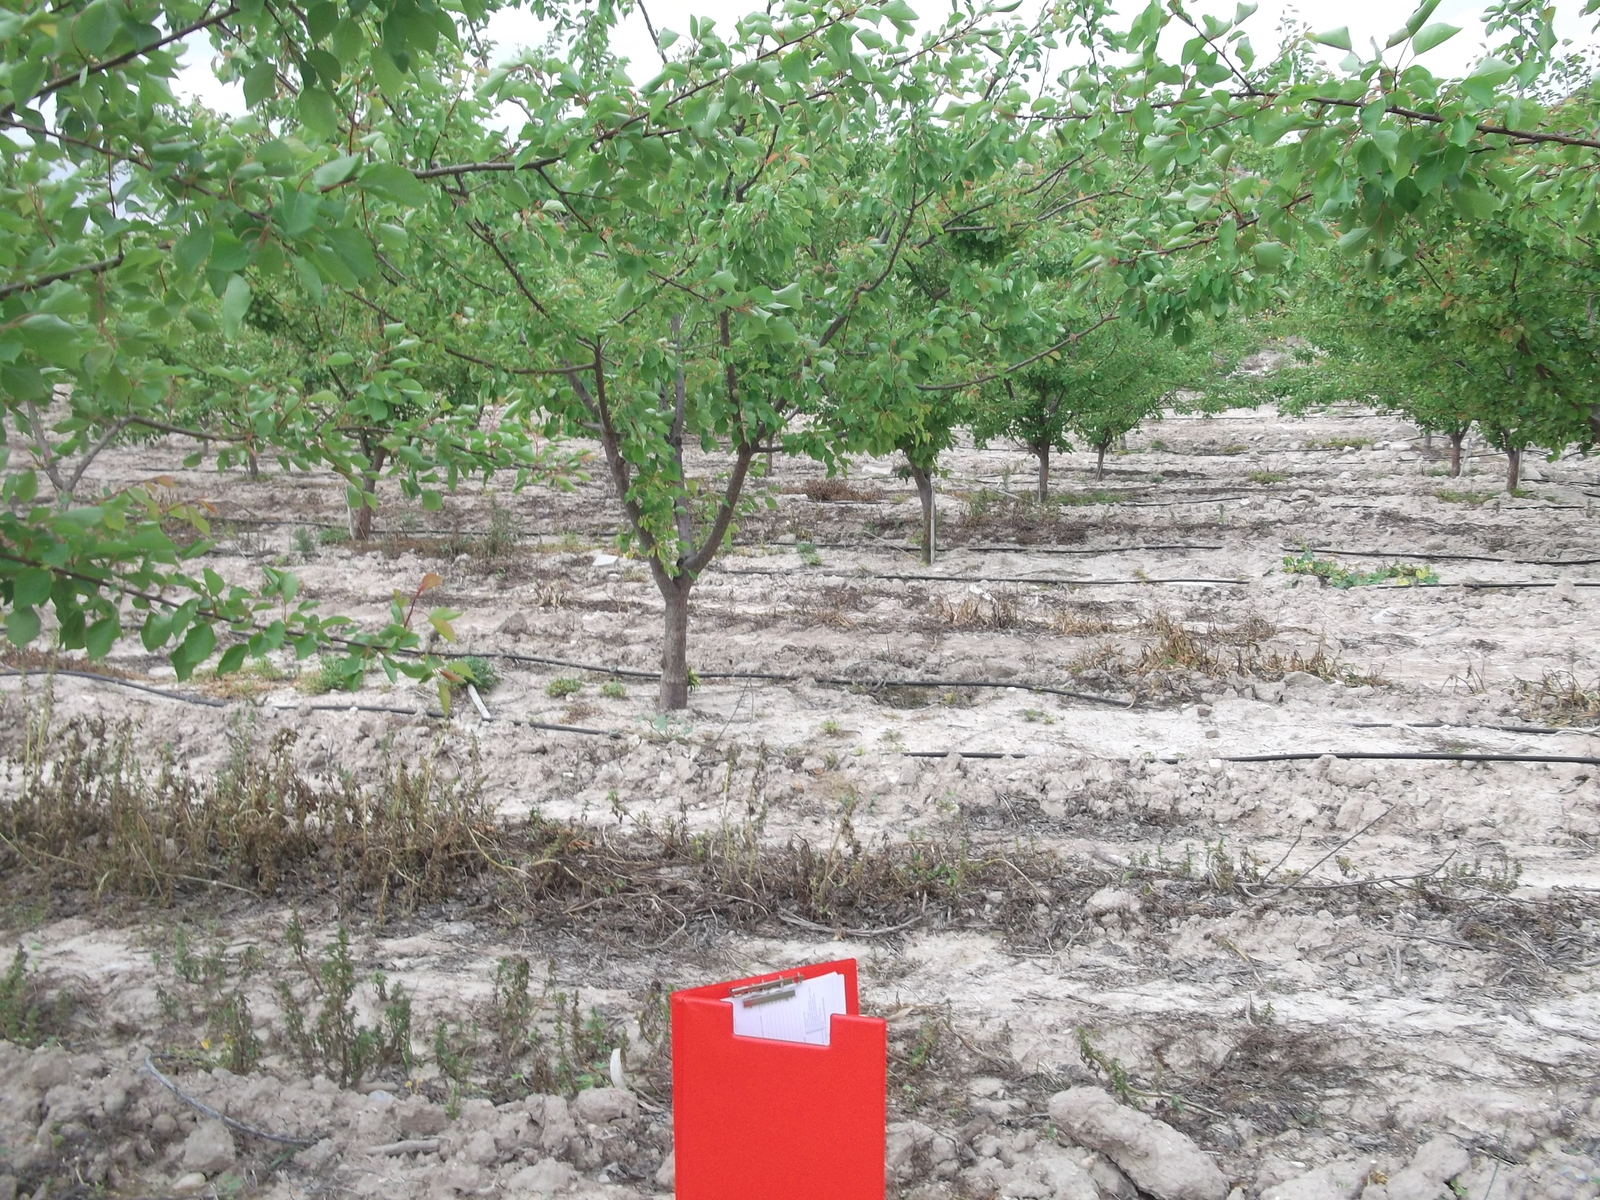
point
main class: Cropland
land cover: Other fruit trees and berries
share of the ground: < 10 %
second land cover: Other bare soil
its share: > 75 %
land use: Agriculture (excluding fallow land and kitchen gardens)
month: April
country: ES
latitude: 38.0403
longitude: -1.4601
